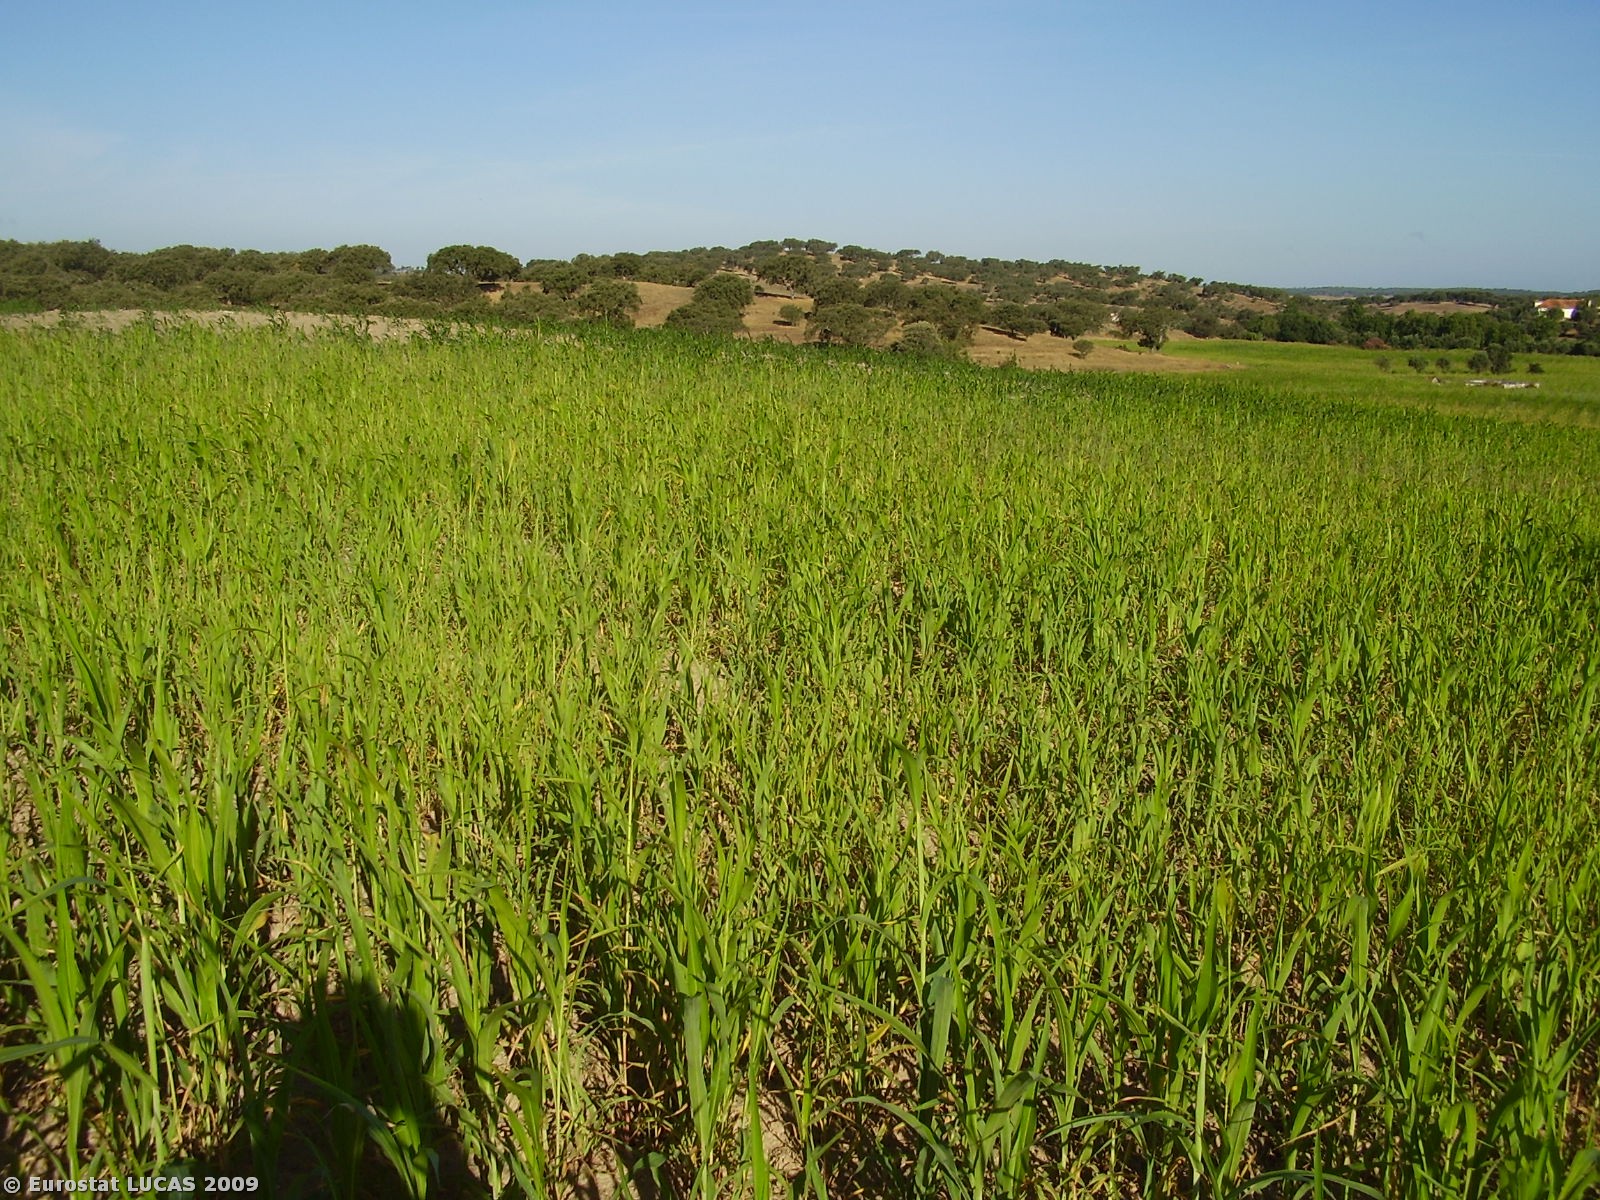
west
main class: Cropland
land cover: Mixed cereals for fodder
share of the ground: 50 - 75 %
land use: Agriculture (excluding fallow land and kitchen gardens)
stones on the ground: 25 - 50 %
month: July
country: PT
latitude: 38.9404
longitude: -7.9885
